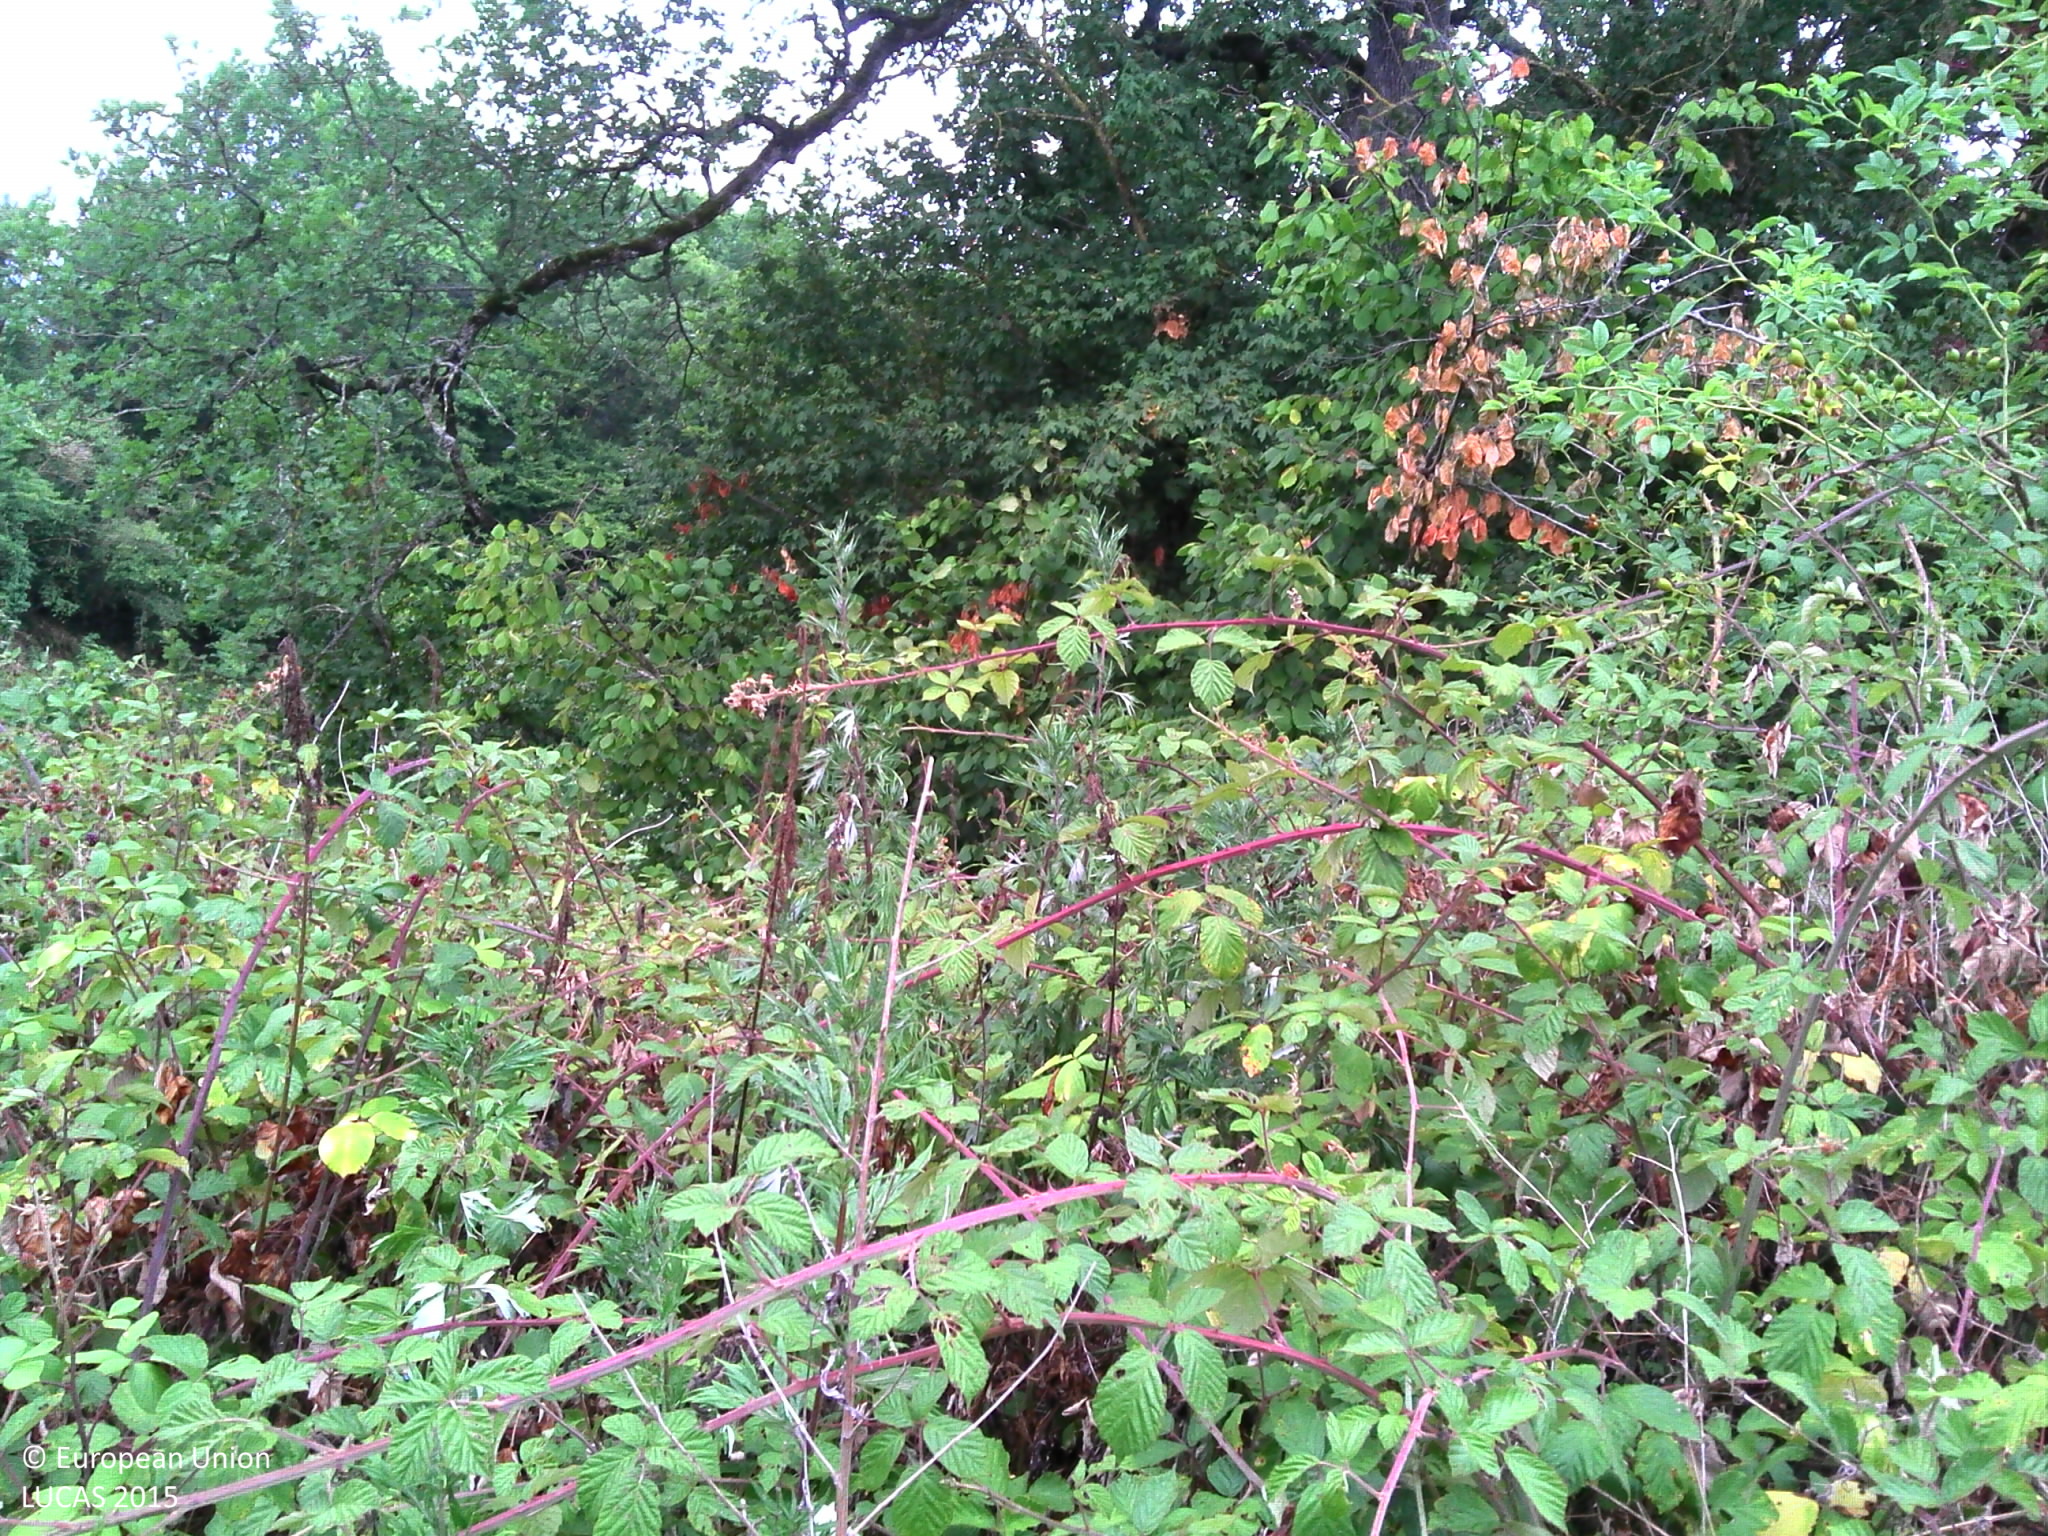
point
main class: Woodland
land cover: Broadleaved woodland
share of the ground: > 75 %
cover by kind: broadleaved forest trees 70 %, shrubs 30 %
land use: Semi-natural and natural areas not in use
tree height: > 5 m
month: July
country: FR
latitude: 44.2935
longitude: 0.6827
